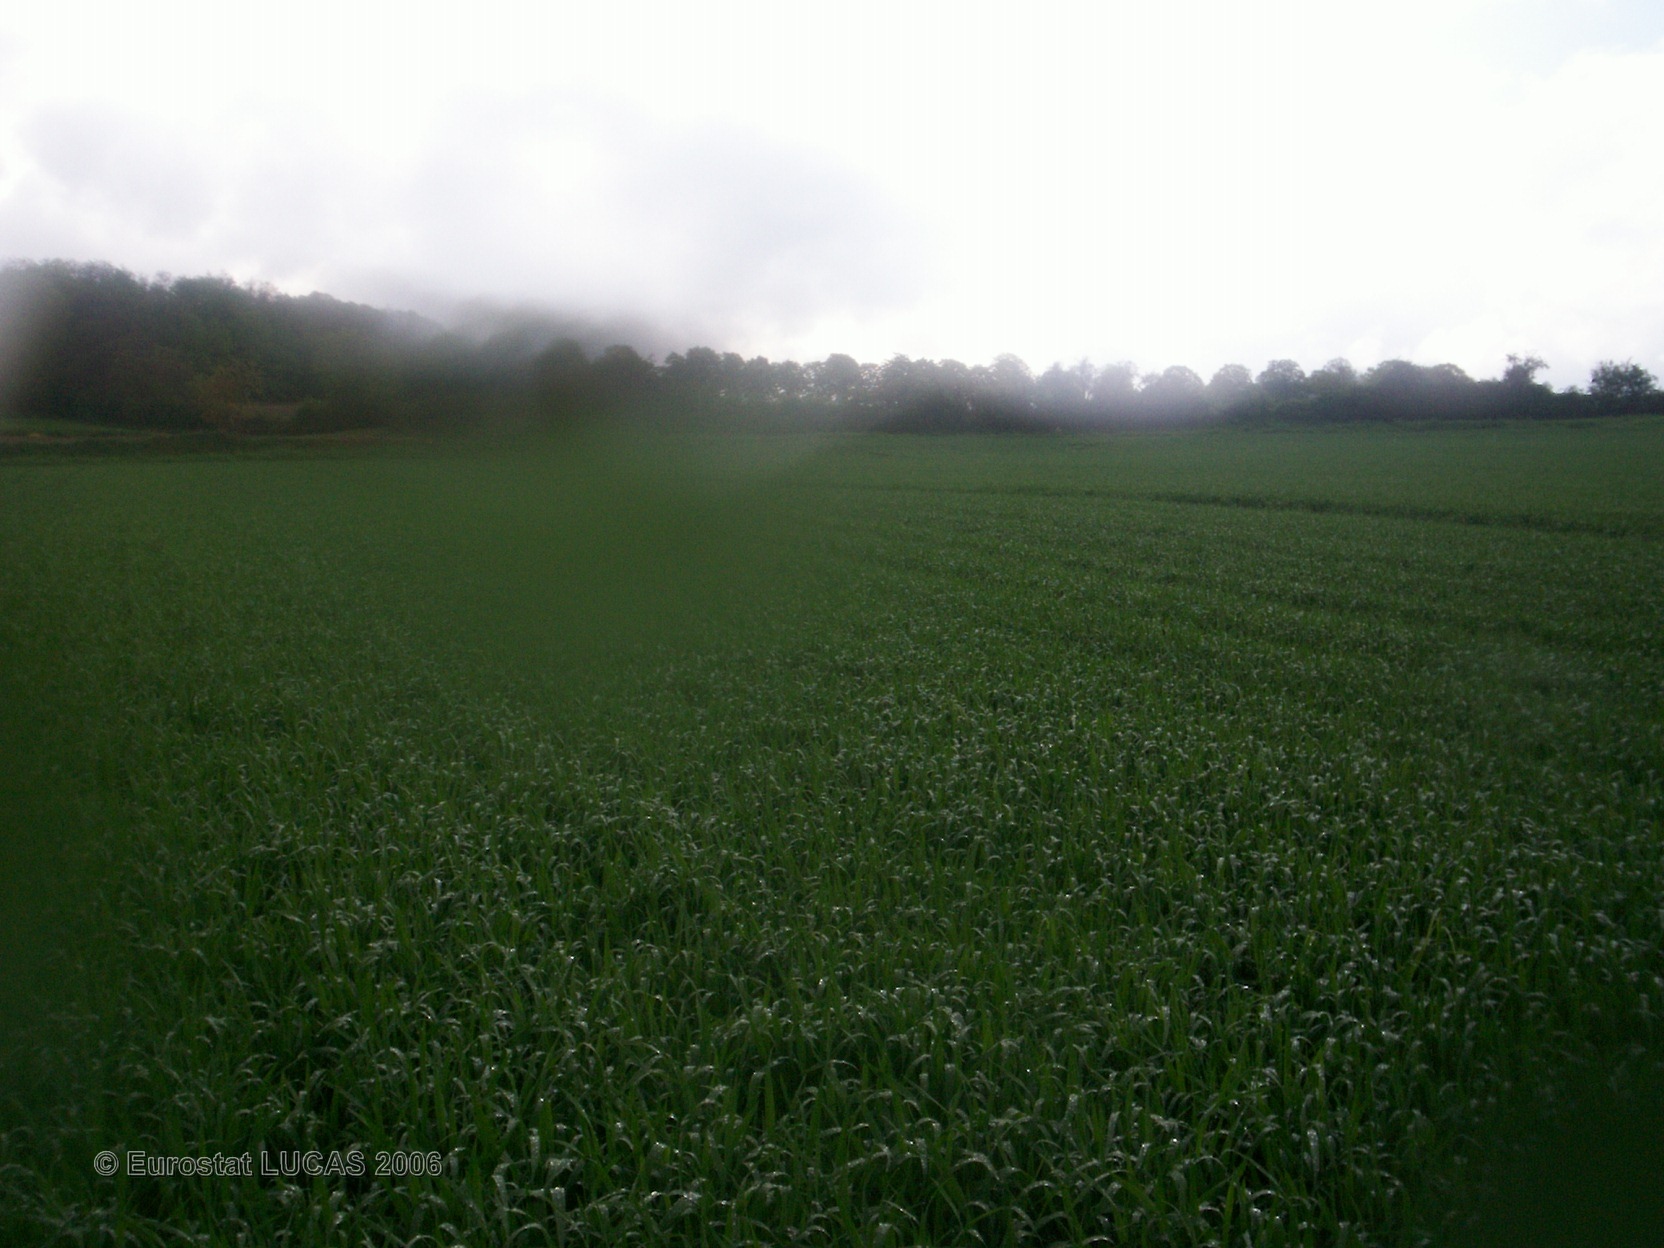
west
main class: Cropland
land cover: Common wheat
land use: Agriculture (excluding fallow land and kitchen gardens)
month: May
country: FR
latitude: 45.6050
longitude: 3.1152
